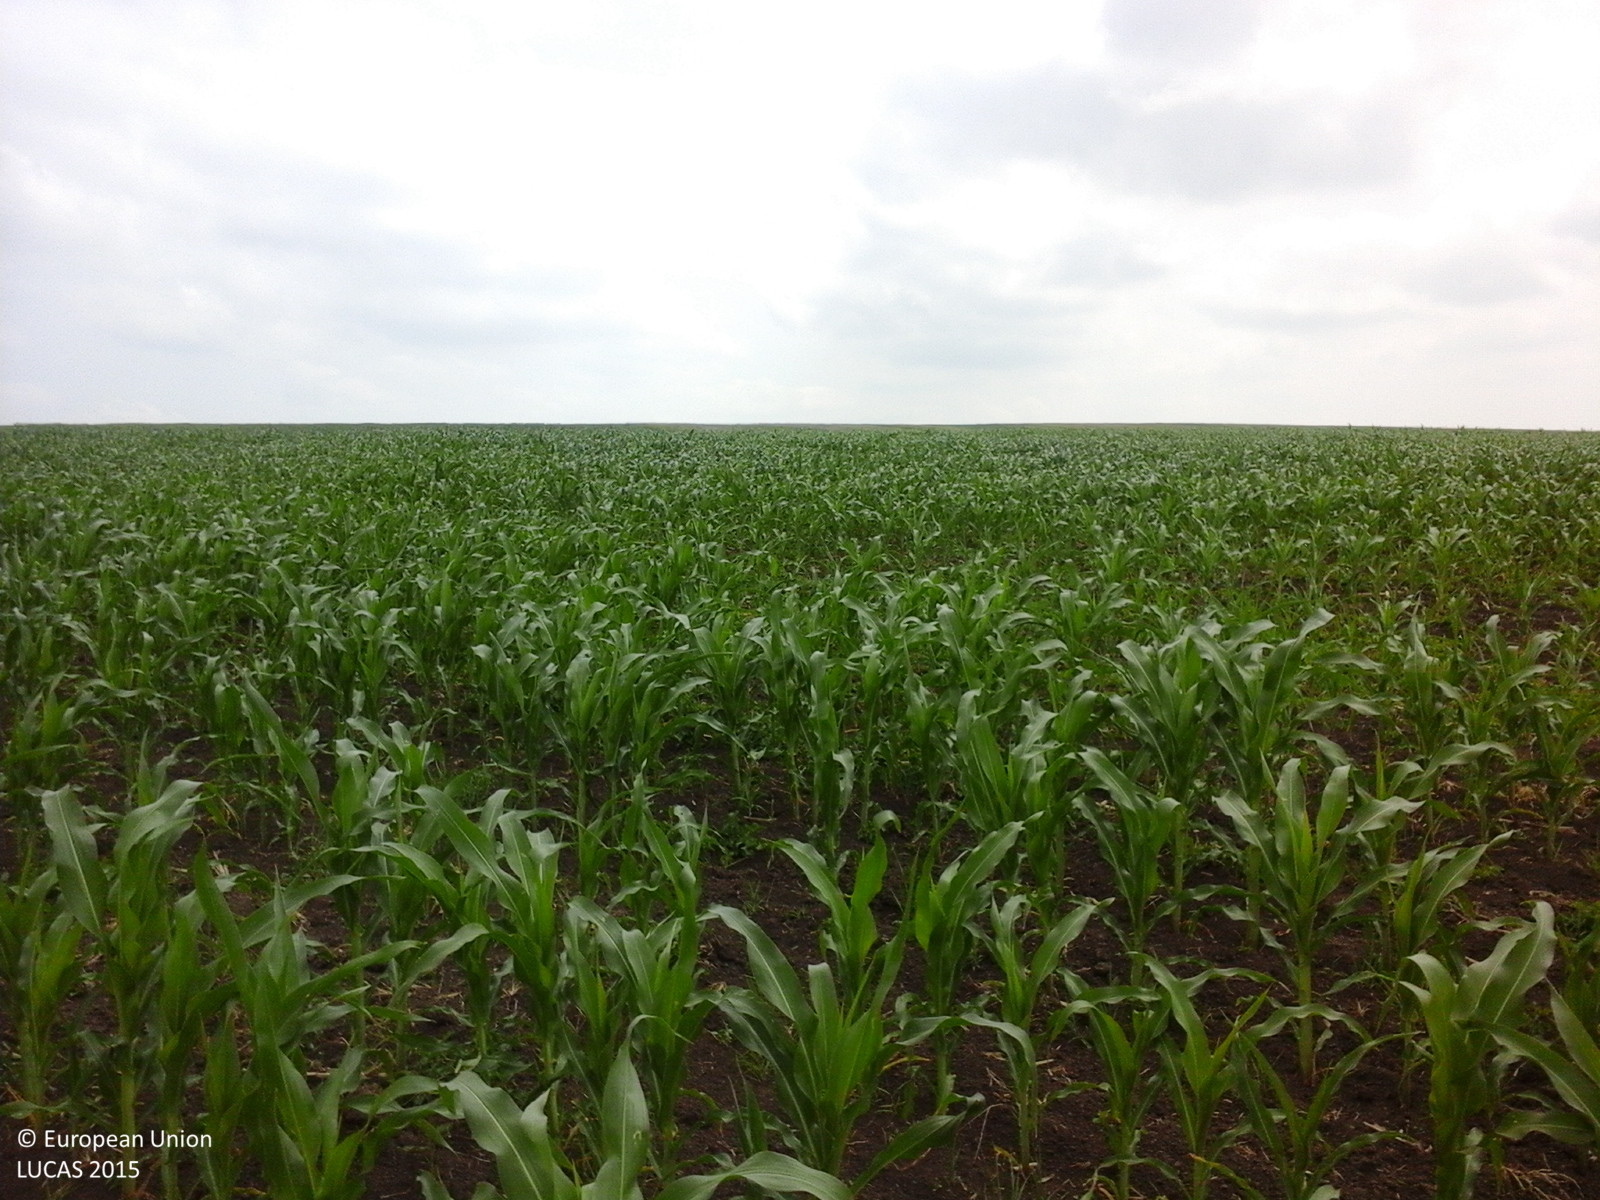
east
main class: Cropland
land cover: Maize
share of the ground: 50 - 75 %
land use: Agriculture (excluding fallow land and kitchen gardens)
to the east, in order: Maize; Grass margins; Tracks; Grassland without tree/shrub cover; Spontaneously vegetated surfaces
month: June
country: RO
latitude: 47.8628
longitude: 26.6577
